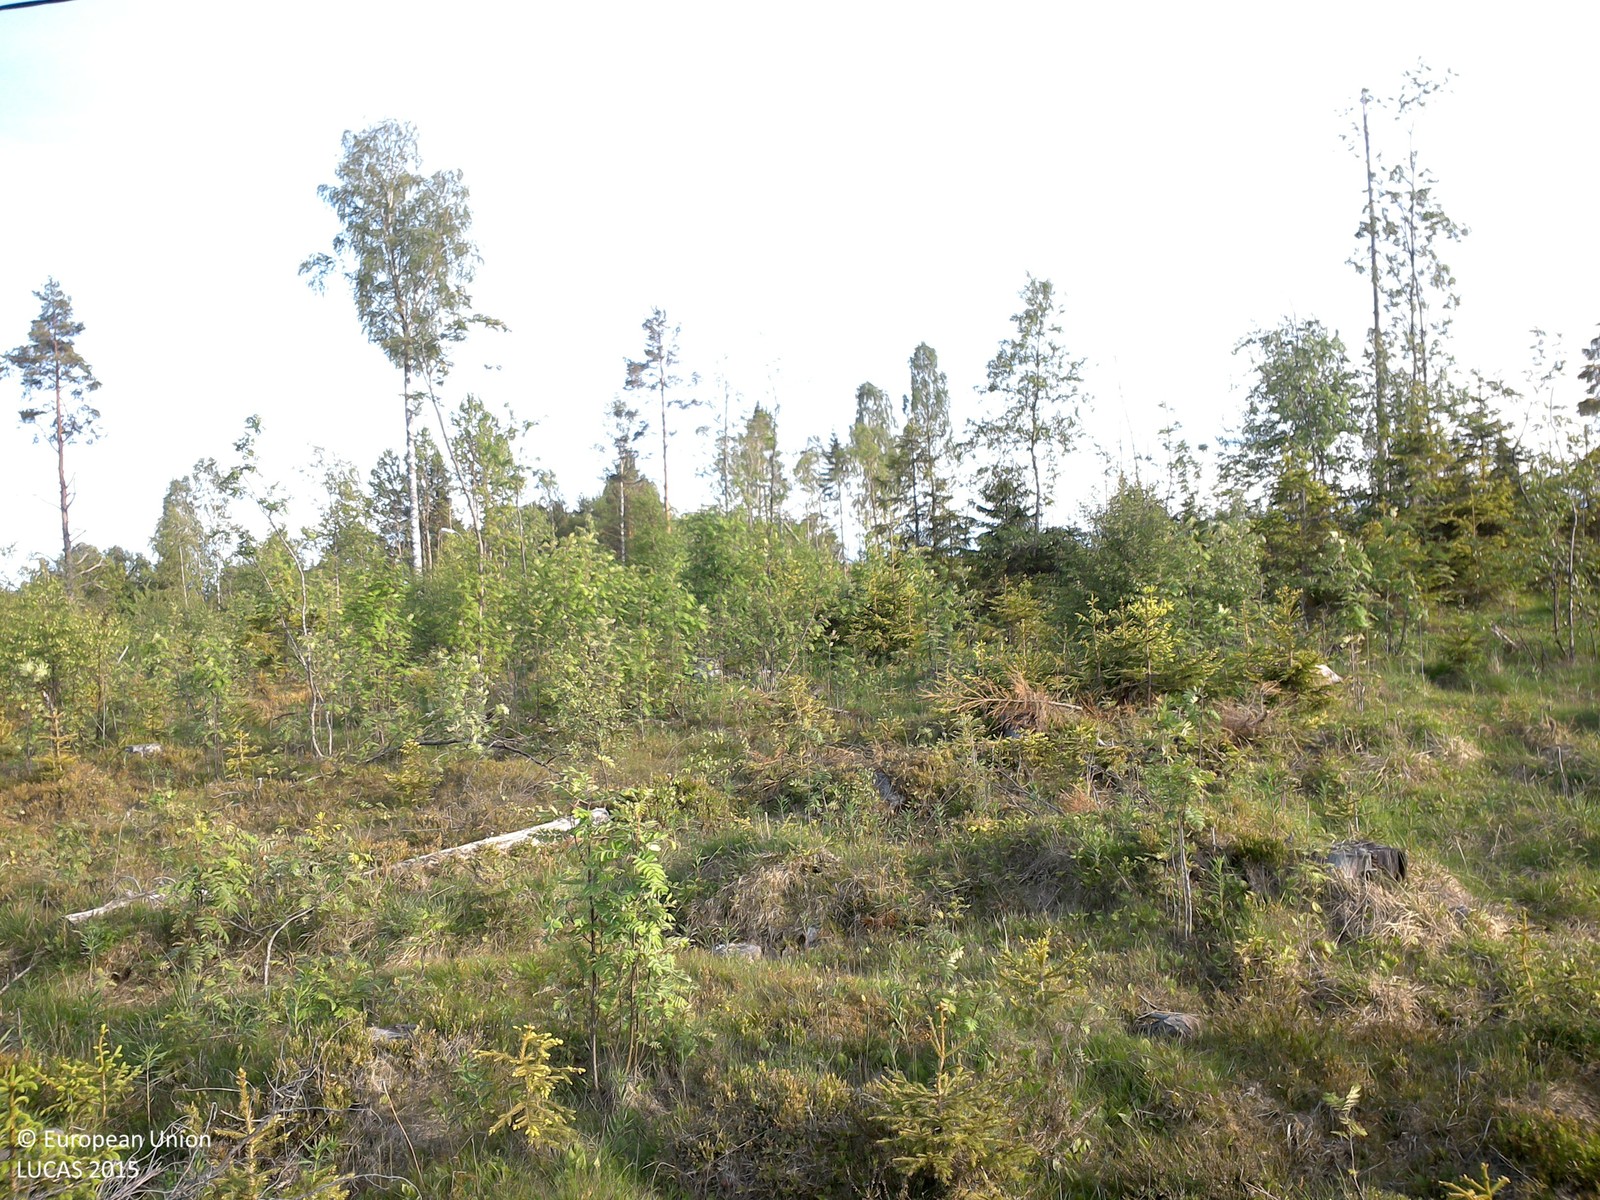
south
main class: Woodland
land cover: Broadleaved woodland
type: boreal forest
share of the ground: 10 - 25 %
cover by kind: herbaceous plants 85 %, broadleaved forest trees 15 %
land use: Forestry
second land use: Sport
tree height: < 5 m
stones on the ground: < 10 %
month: June
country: SE
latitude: 62.6416
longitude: 17.8797
